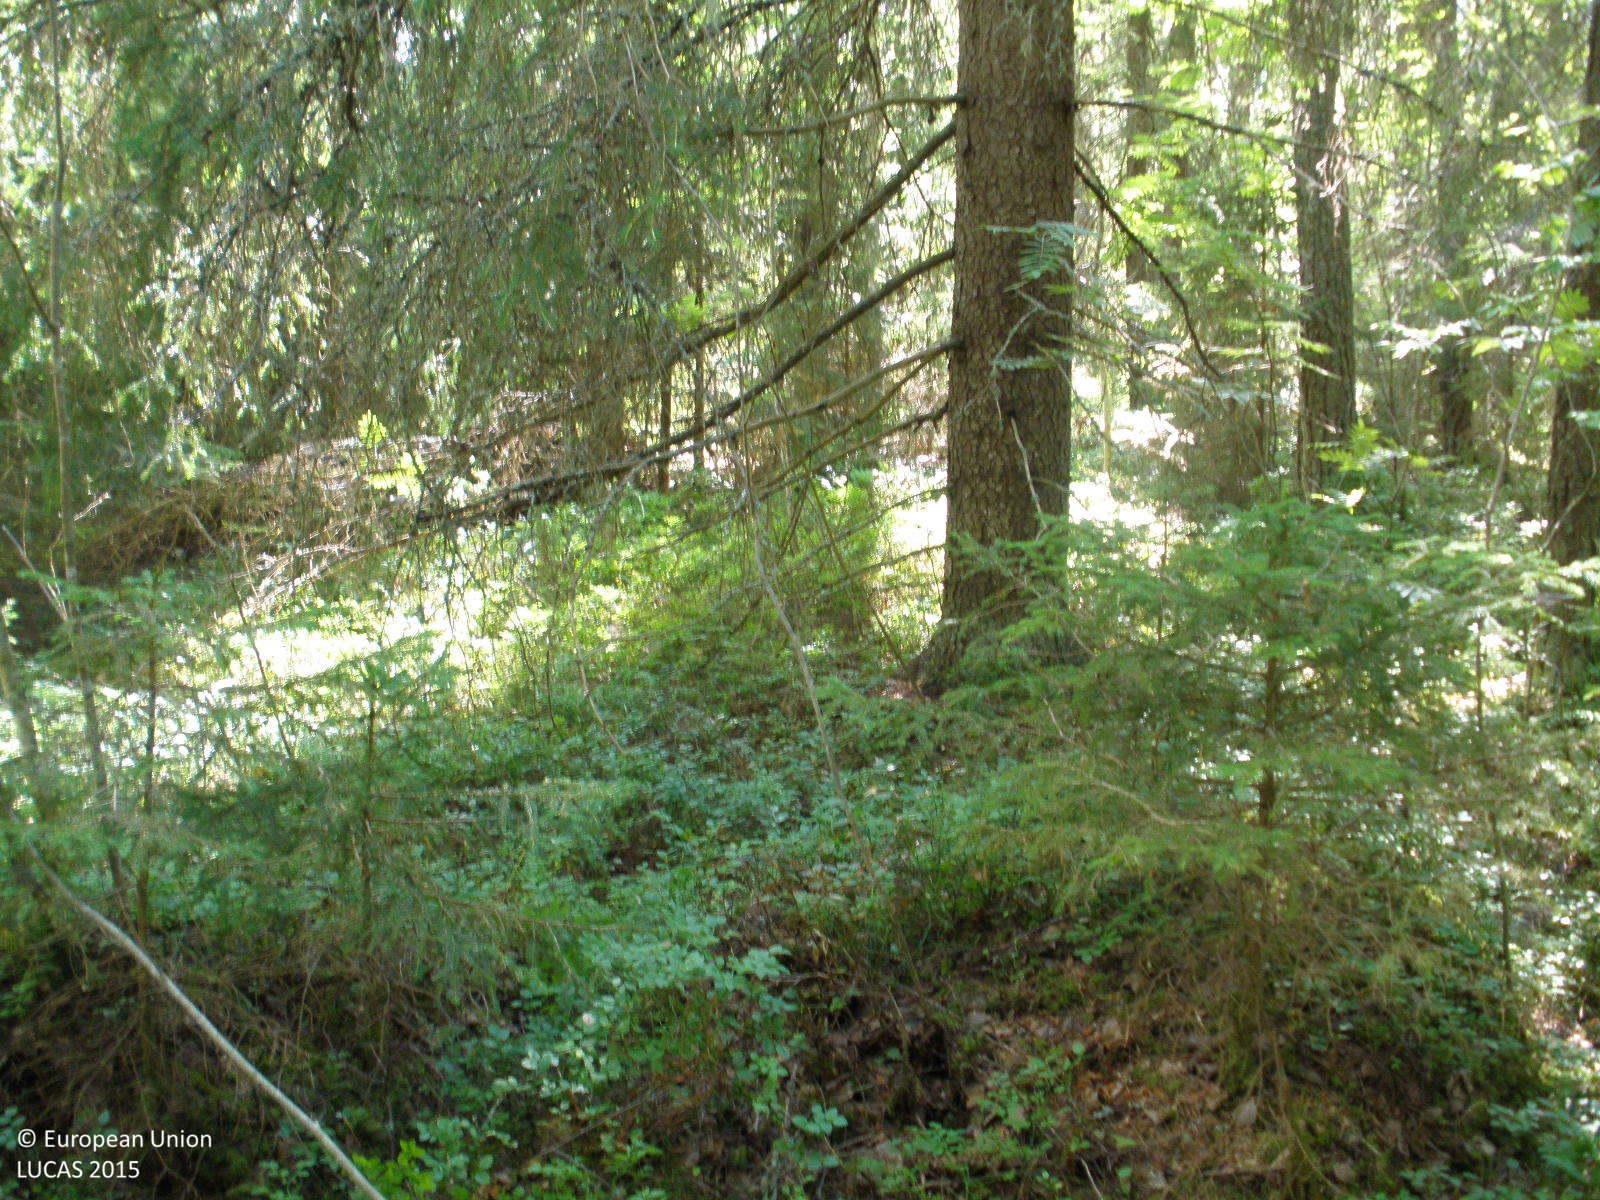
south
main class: Woodland
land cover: Spruce dominated mixed woodland
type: boreal forest
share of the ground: > 75 %
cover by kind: coniferous forest trees 60 %, broadleaved forest trees 25 %, herbaceous plants 10 %, lichens and mosses 5 %
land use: Forestry
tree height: > 5 m
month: July
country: FI
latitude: 61.6053
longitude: 24.5571
